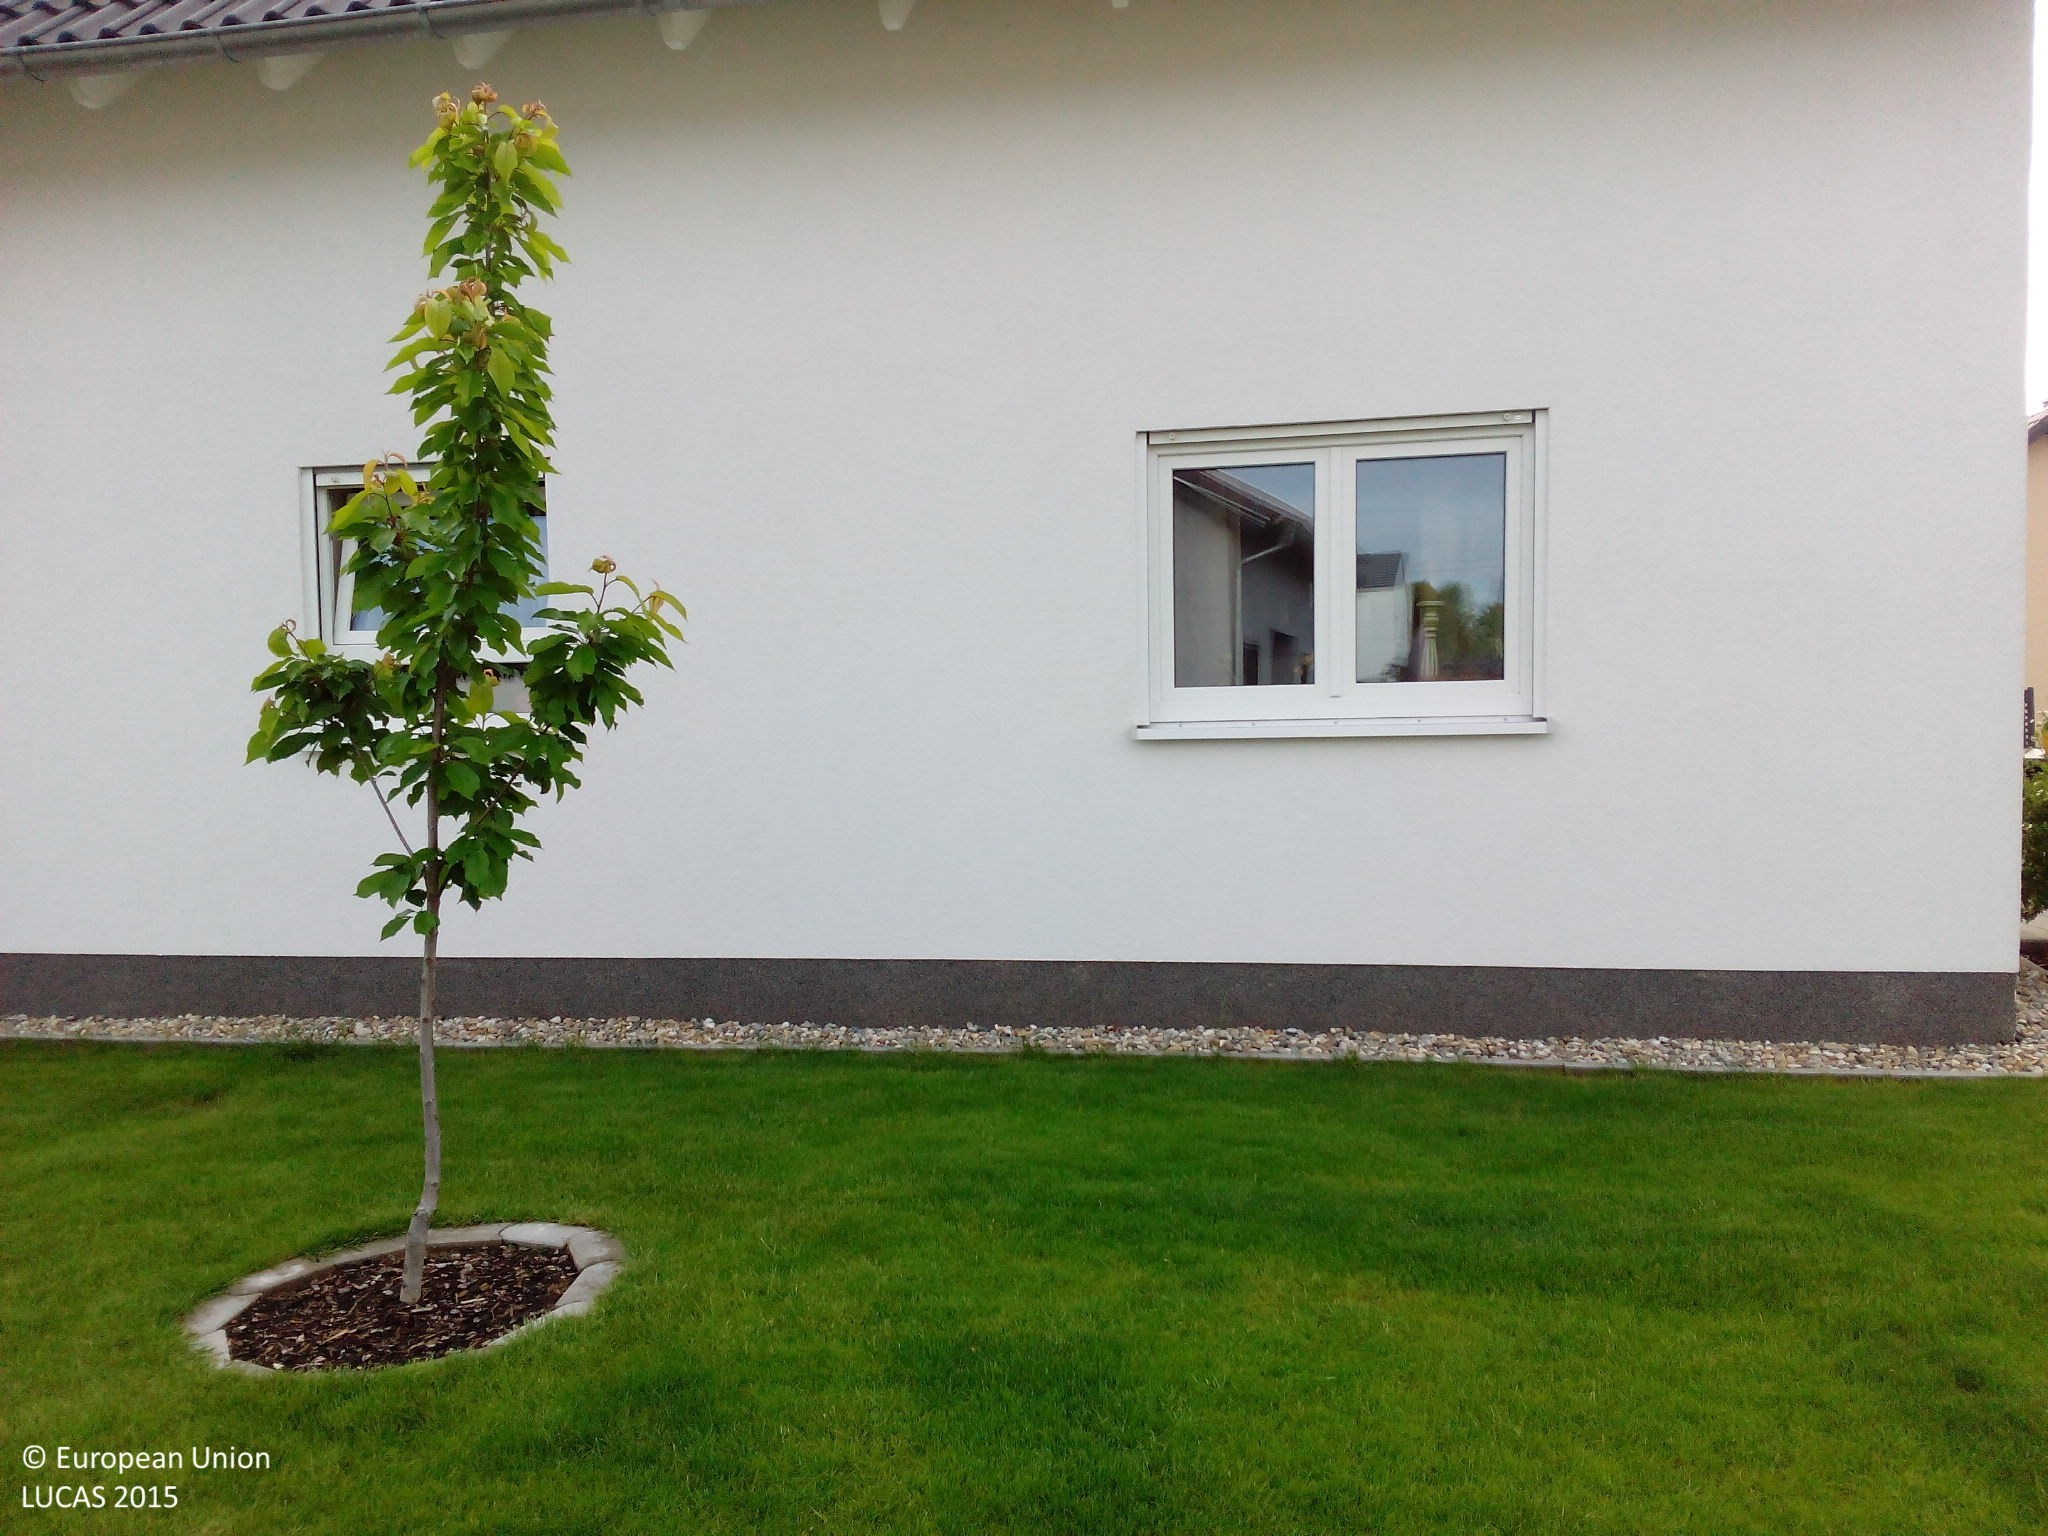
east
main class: Grassland
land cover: Grassland without tree/shrub cover
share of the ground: > 75 %
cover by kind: herbaceous plants 95 %, unconsolidated bare surface 5 %
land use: Residential
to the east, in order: Grassland without tree/shrub cover; Artificial constructions in urban areas; Broadleaved woodland; Tracks; Other bare soil
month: May
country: DE
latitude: 49.0719
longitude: 8.1526
